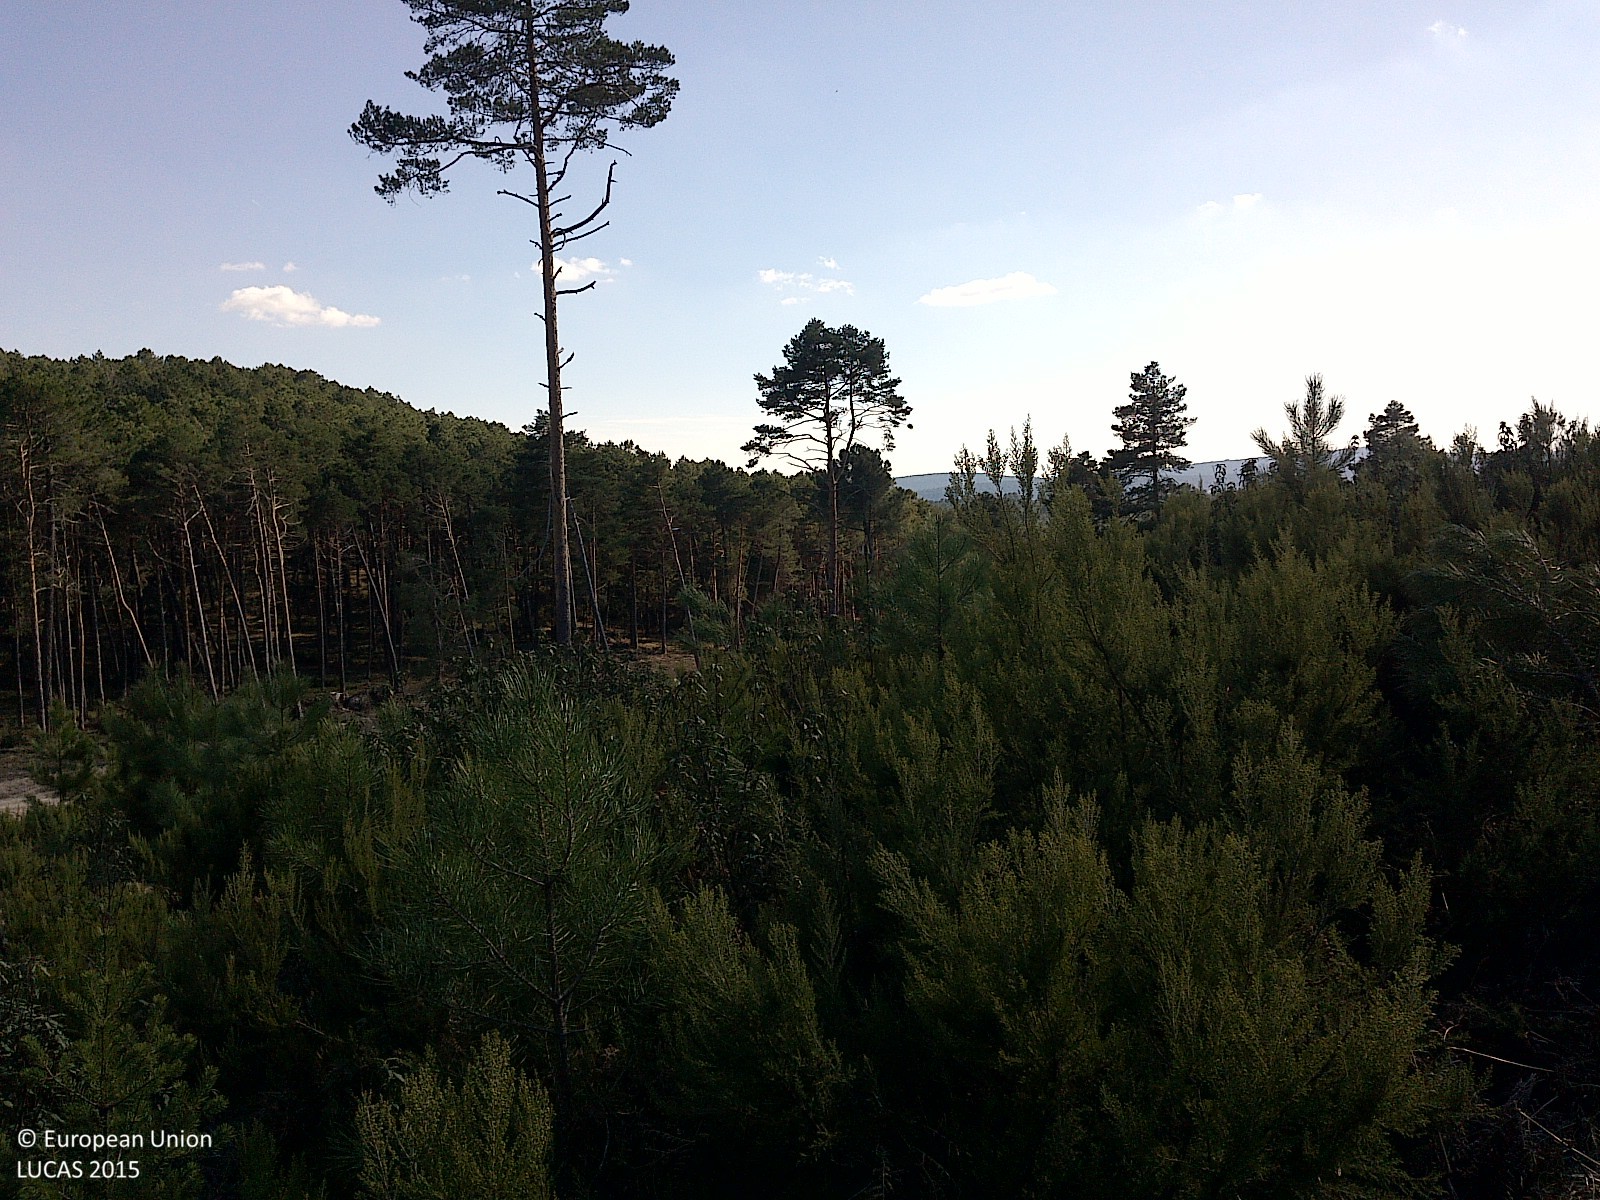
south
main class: Woodland
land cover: Pine dominated coniferous woodland
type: coniferous forest of the mediterranean region
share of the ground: 25 - 50 %
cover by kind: shrubs 45 %, coniferous forest trees 30 %, herbaceous plants 25 %
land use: Forestry
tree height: > 5 m
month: April
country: ES
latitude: 41.8875
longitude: -3.1233
